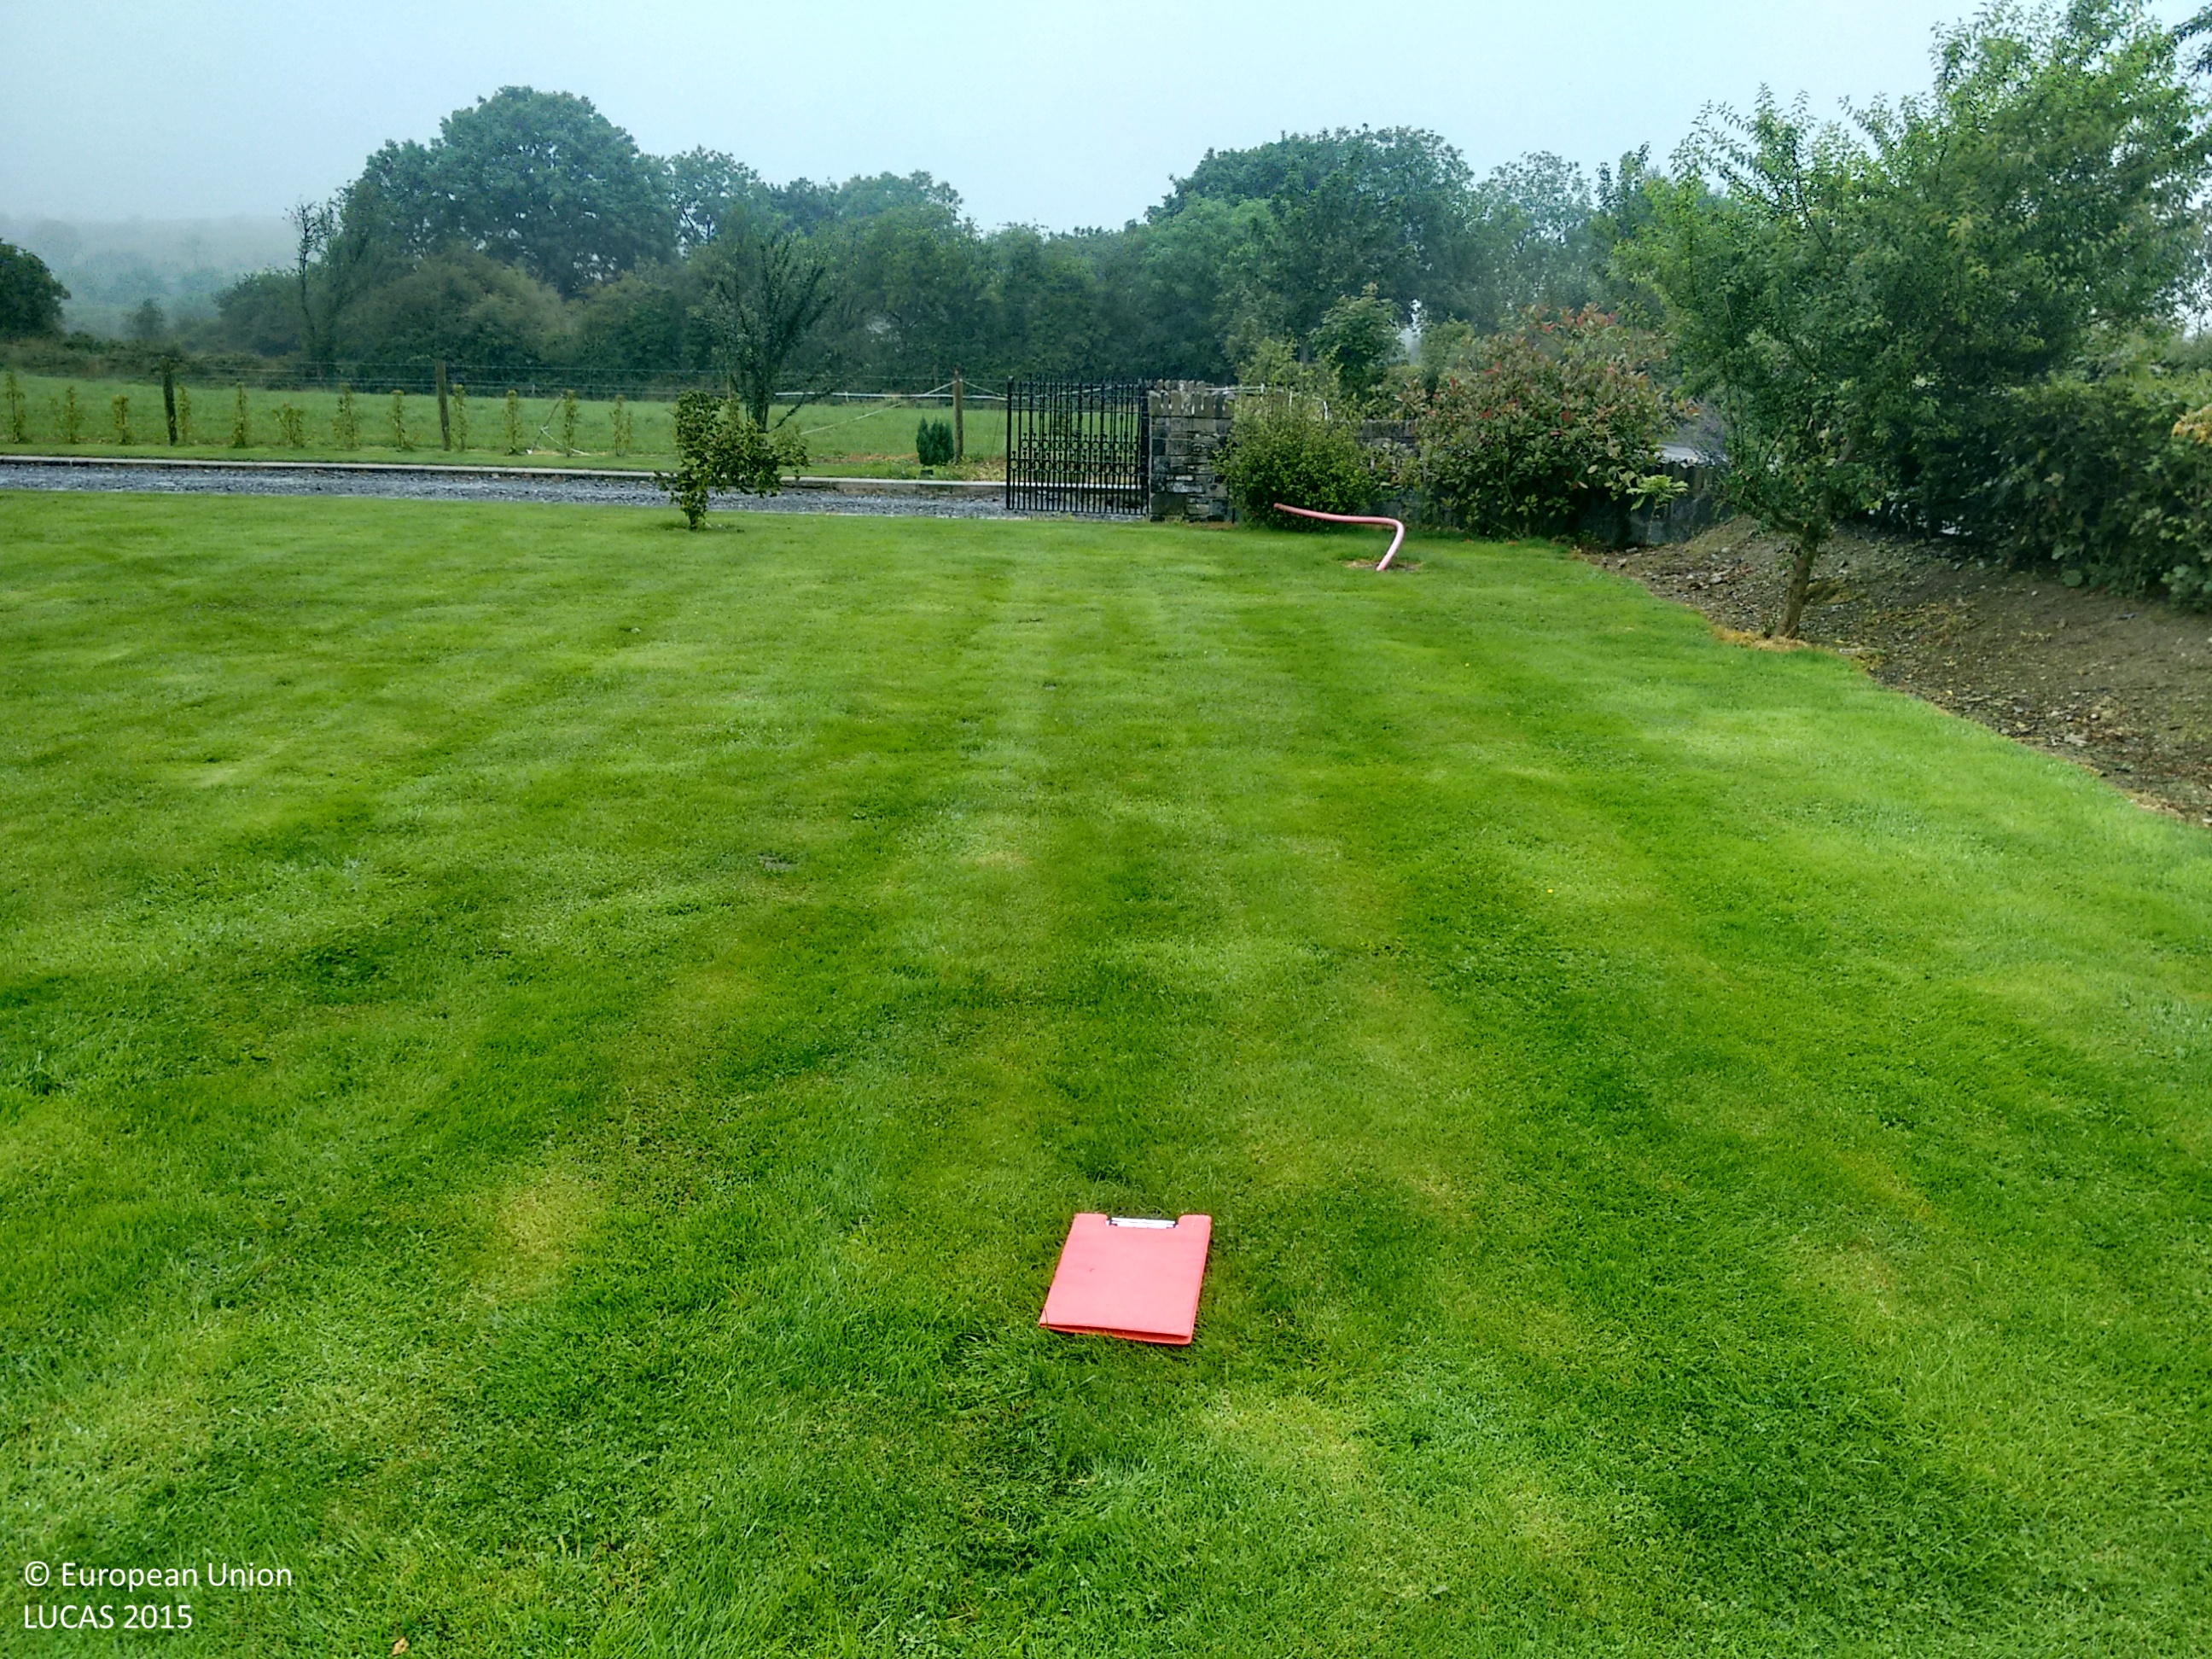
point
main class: Grassland
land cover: Grassland without tree/shrub cover
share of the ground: > 75 %
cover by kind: herbaceous plants 100 %
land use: Residential
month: August
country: IE
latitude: 54.0030
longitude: -6.7791
